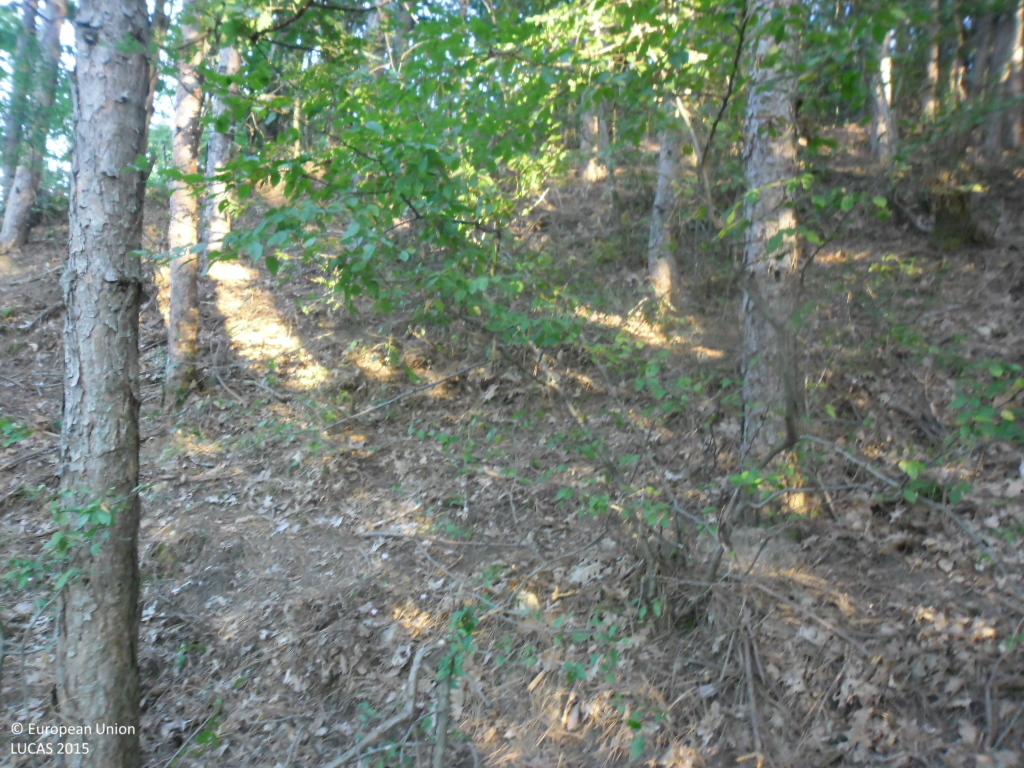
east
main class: Woodland
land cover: Pine dominated mixed woodland
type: hemiboreal forest and nemoral coniferous forest and mixed broadleaved-coniferous forest
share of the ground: > 75 %
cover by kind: coniferous forest trees 75 %, broadleaved forest trees 25 %
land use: Forestry
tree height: > 5 m
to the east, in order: Pine dominated mixed woodland; Grassland without tree/shrub cover; Broadleaved woodland; Grassland without tree/shrub cover; Broadleaved woodland; Grassland without tree/shrub cover; Broadleaved woodland; Grassland without tree/shrub cover; Broadleaved woodland
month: September
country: BG
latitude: 41.8373
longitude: 23.0880
